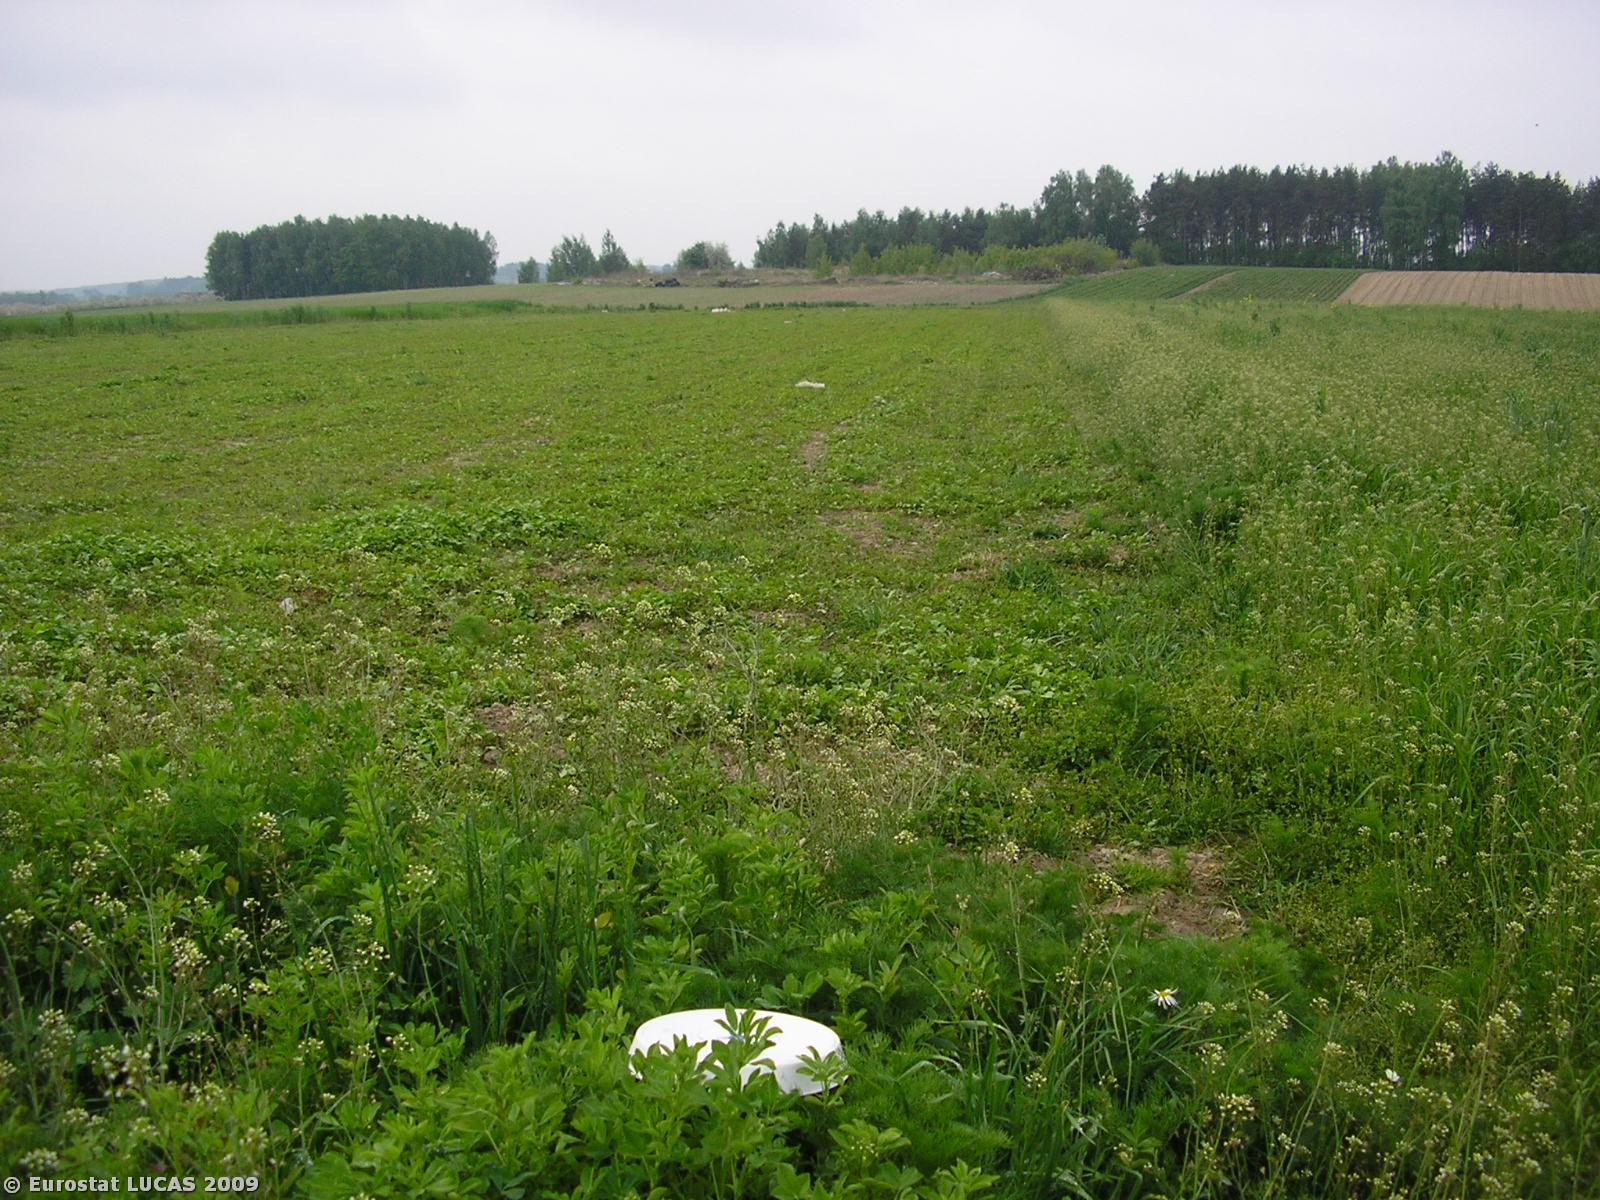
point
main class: Cropland
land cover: Lucerne
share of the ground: > 75 %
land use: Agriculture (excluding fallow land and kitchen gardens)
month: June
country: PL
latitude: 52.4901
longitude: 20.3009
